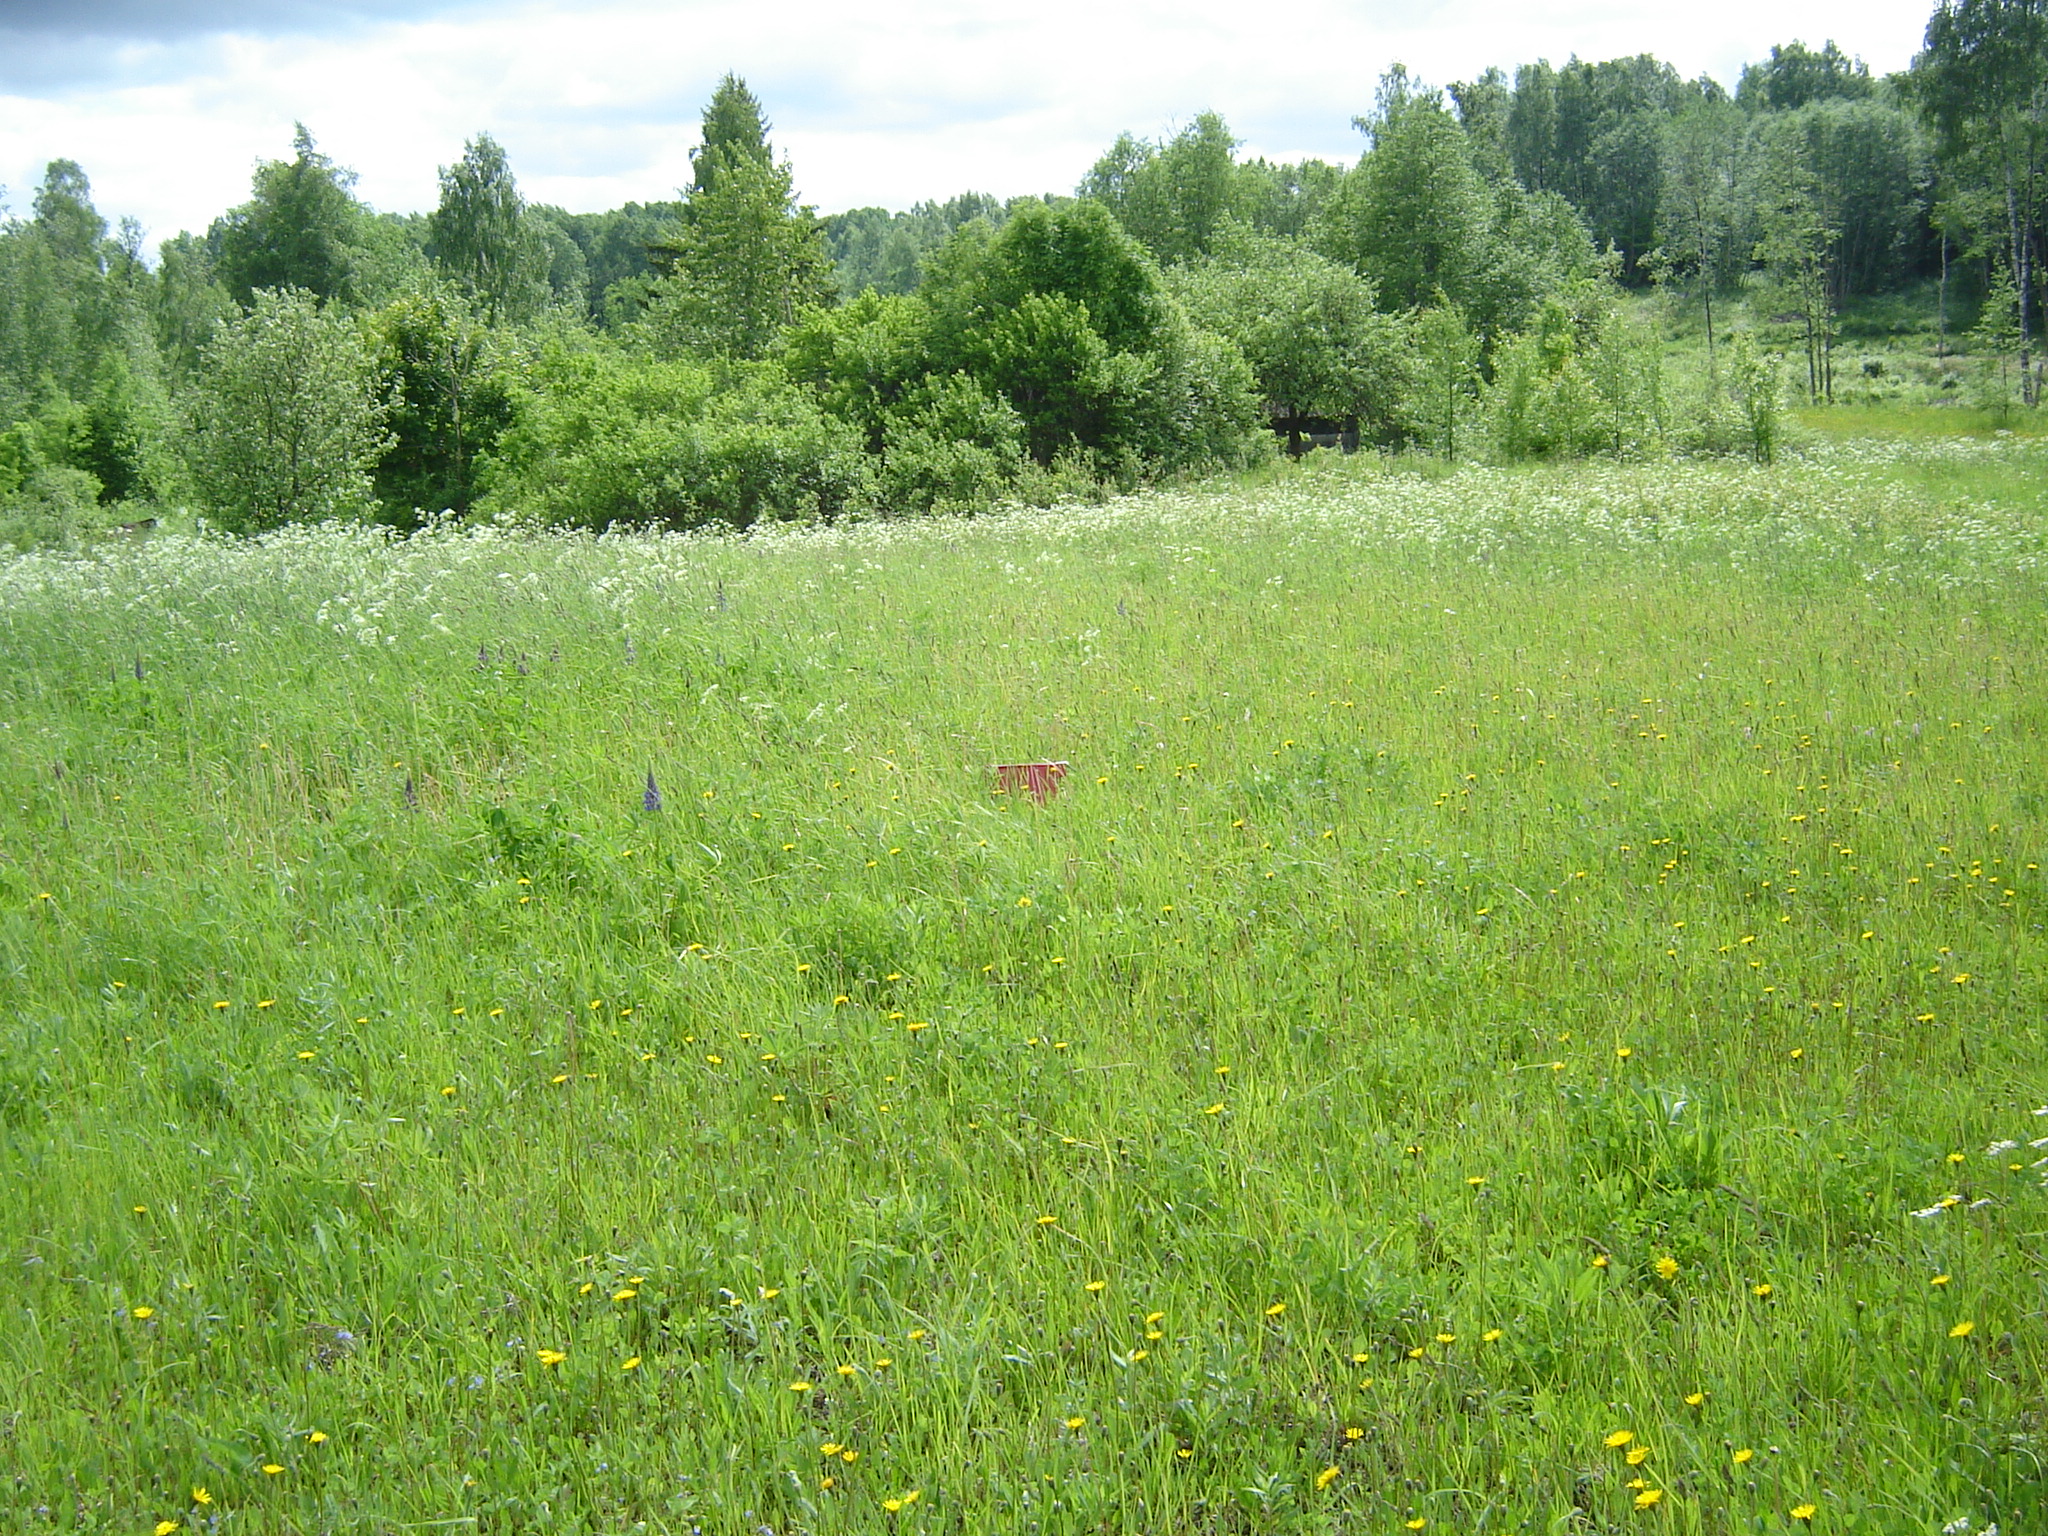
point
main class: Grassland
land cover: Grassland without tree/shrub cover
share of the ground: > 75 %
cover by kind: herbaceous plants 100 %
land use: Agriculture (excluding fallow land and kitchen gardens)
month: June
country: LT
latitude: 55.7049
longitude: 25.5777
